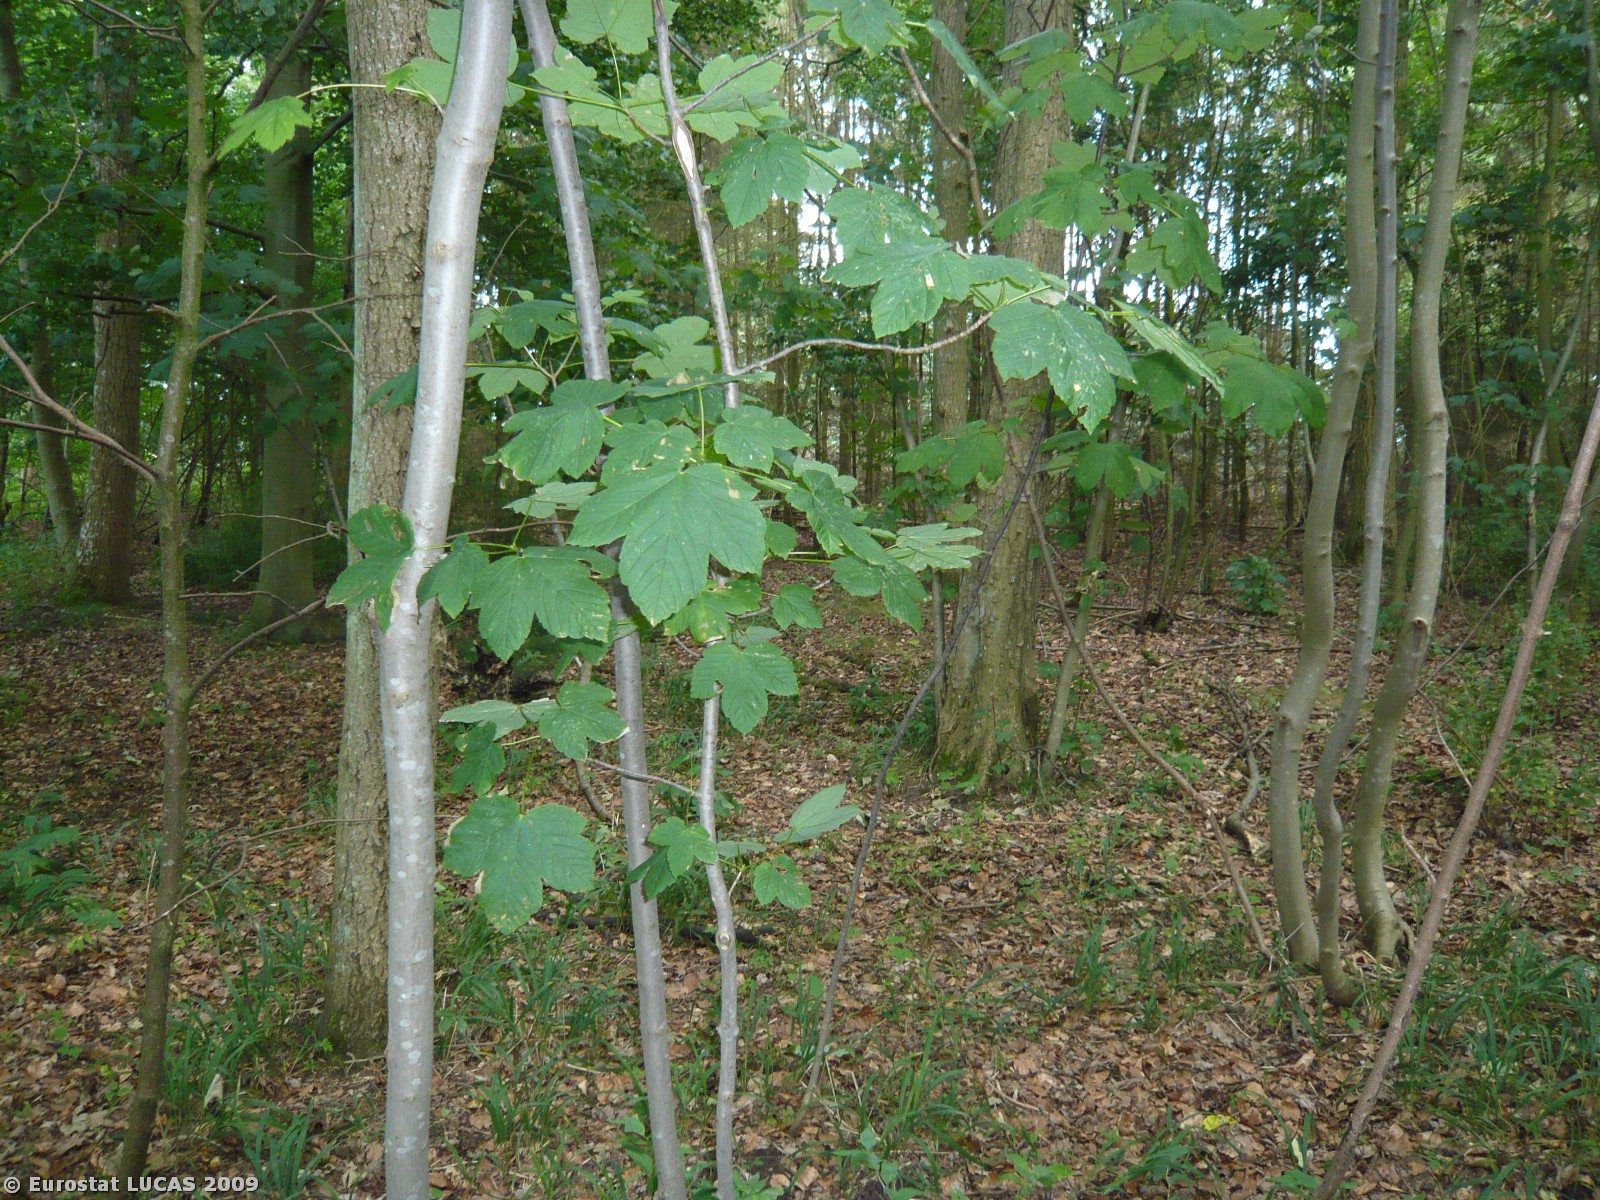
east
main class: Woodland
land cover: Broadleaved woodland
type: mesophytic deciduous forest
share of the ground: > 75 %
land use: Forestry
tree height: > 5 m
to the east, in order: Broadleaved woodland; Maize; Common wheat; Broadleaved woodland; Barley
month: July
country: DK
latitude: 55.3774
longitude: 10.6149
